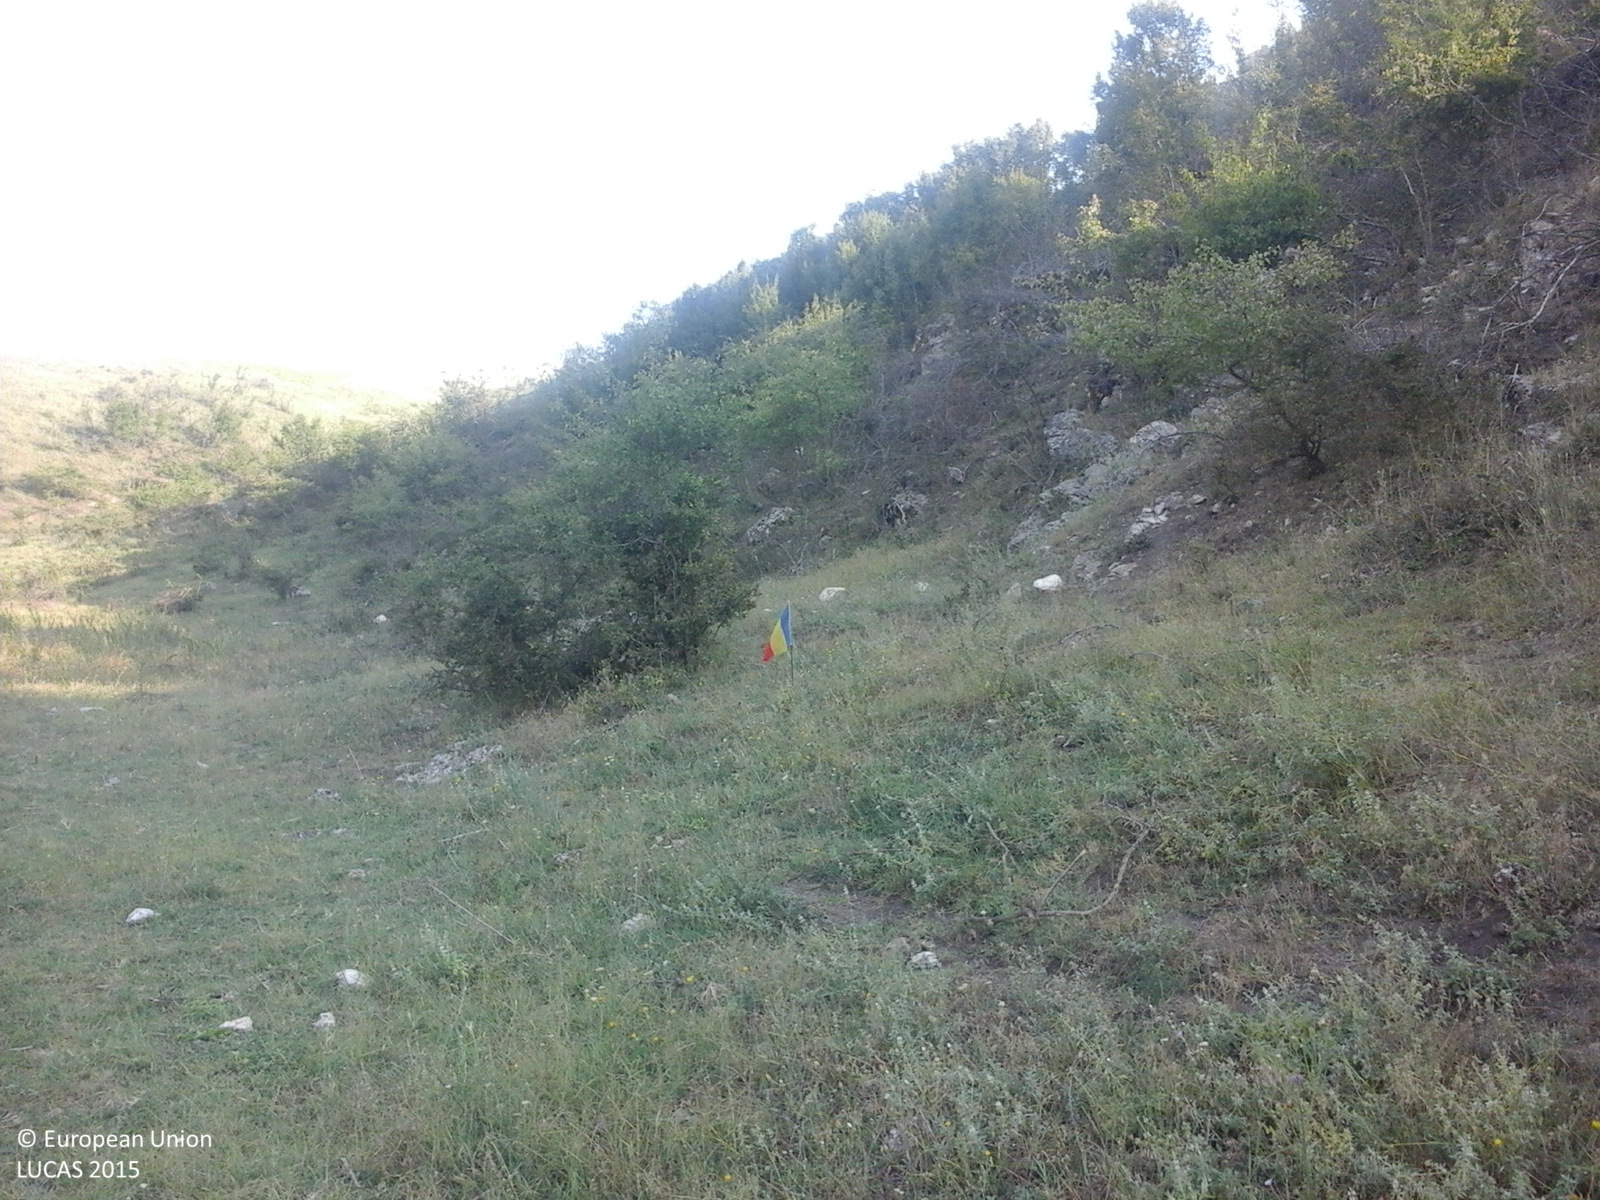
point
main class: Grassland
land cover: Grassland with sparse tree/shrub cover
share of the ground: > 75 %
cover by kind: herbaceous plants 95 %, broadleaved forest trees 5 %
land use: Semi-natural and natural areas not in use
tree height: < 5 m
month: August
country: RO
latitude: 44.1191
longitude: 28.0361
